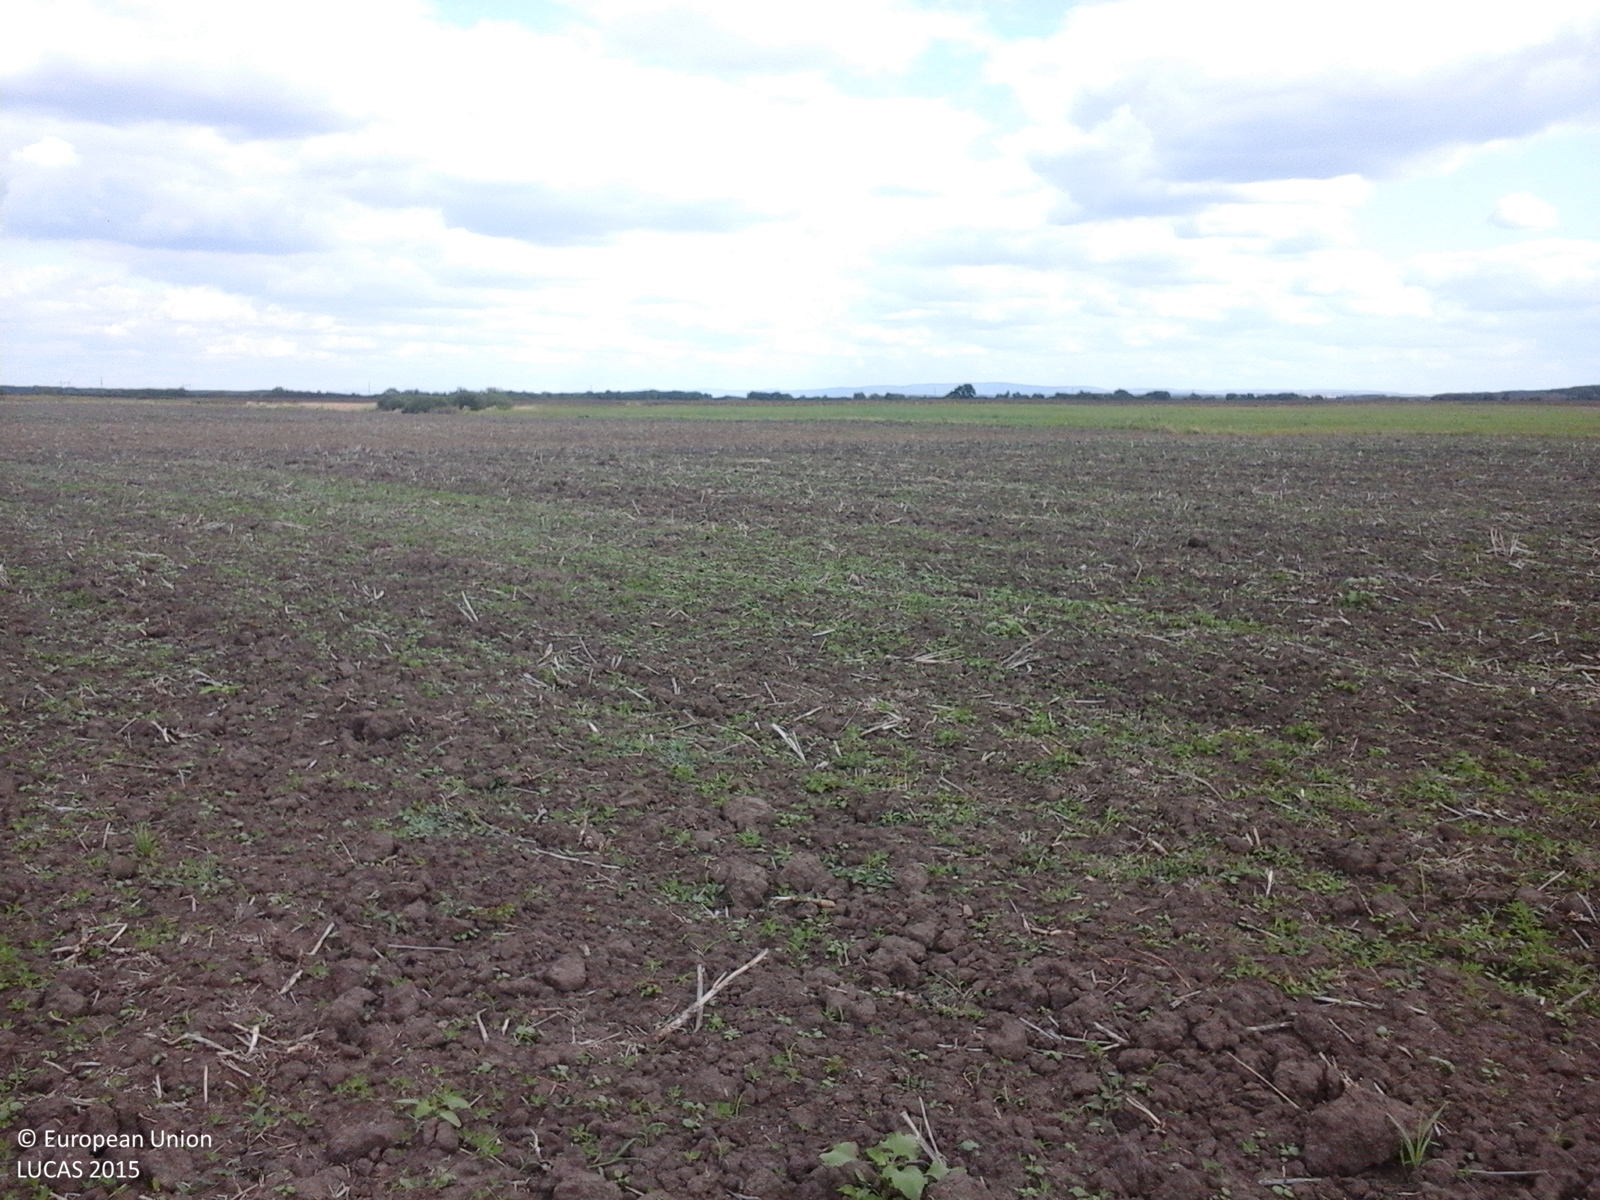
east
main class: Cropland
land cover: Rape and turnip rape
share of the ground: < 10 %
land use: Agriculture (excluding fallow land and kitchen gardens)
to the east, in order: Rape and turnip rape; Spontaneously vegetated surfaces
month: September
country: RO
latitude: 47.5084
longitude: 22.6597
